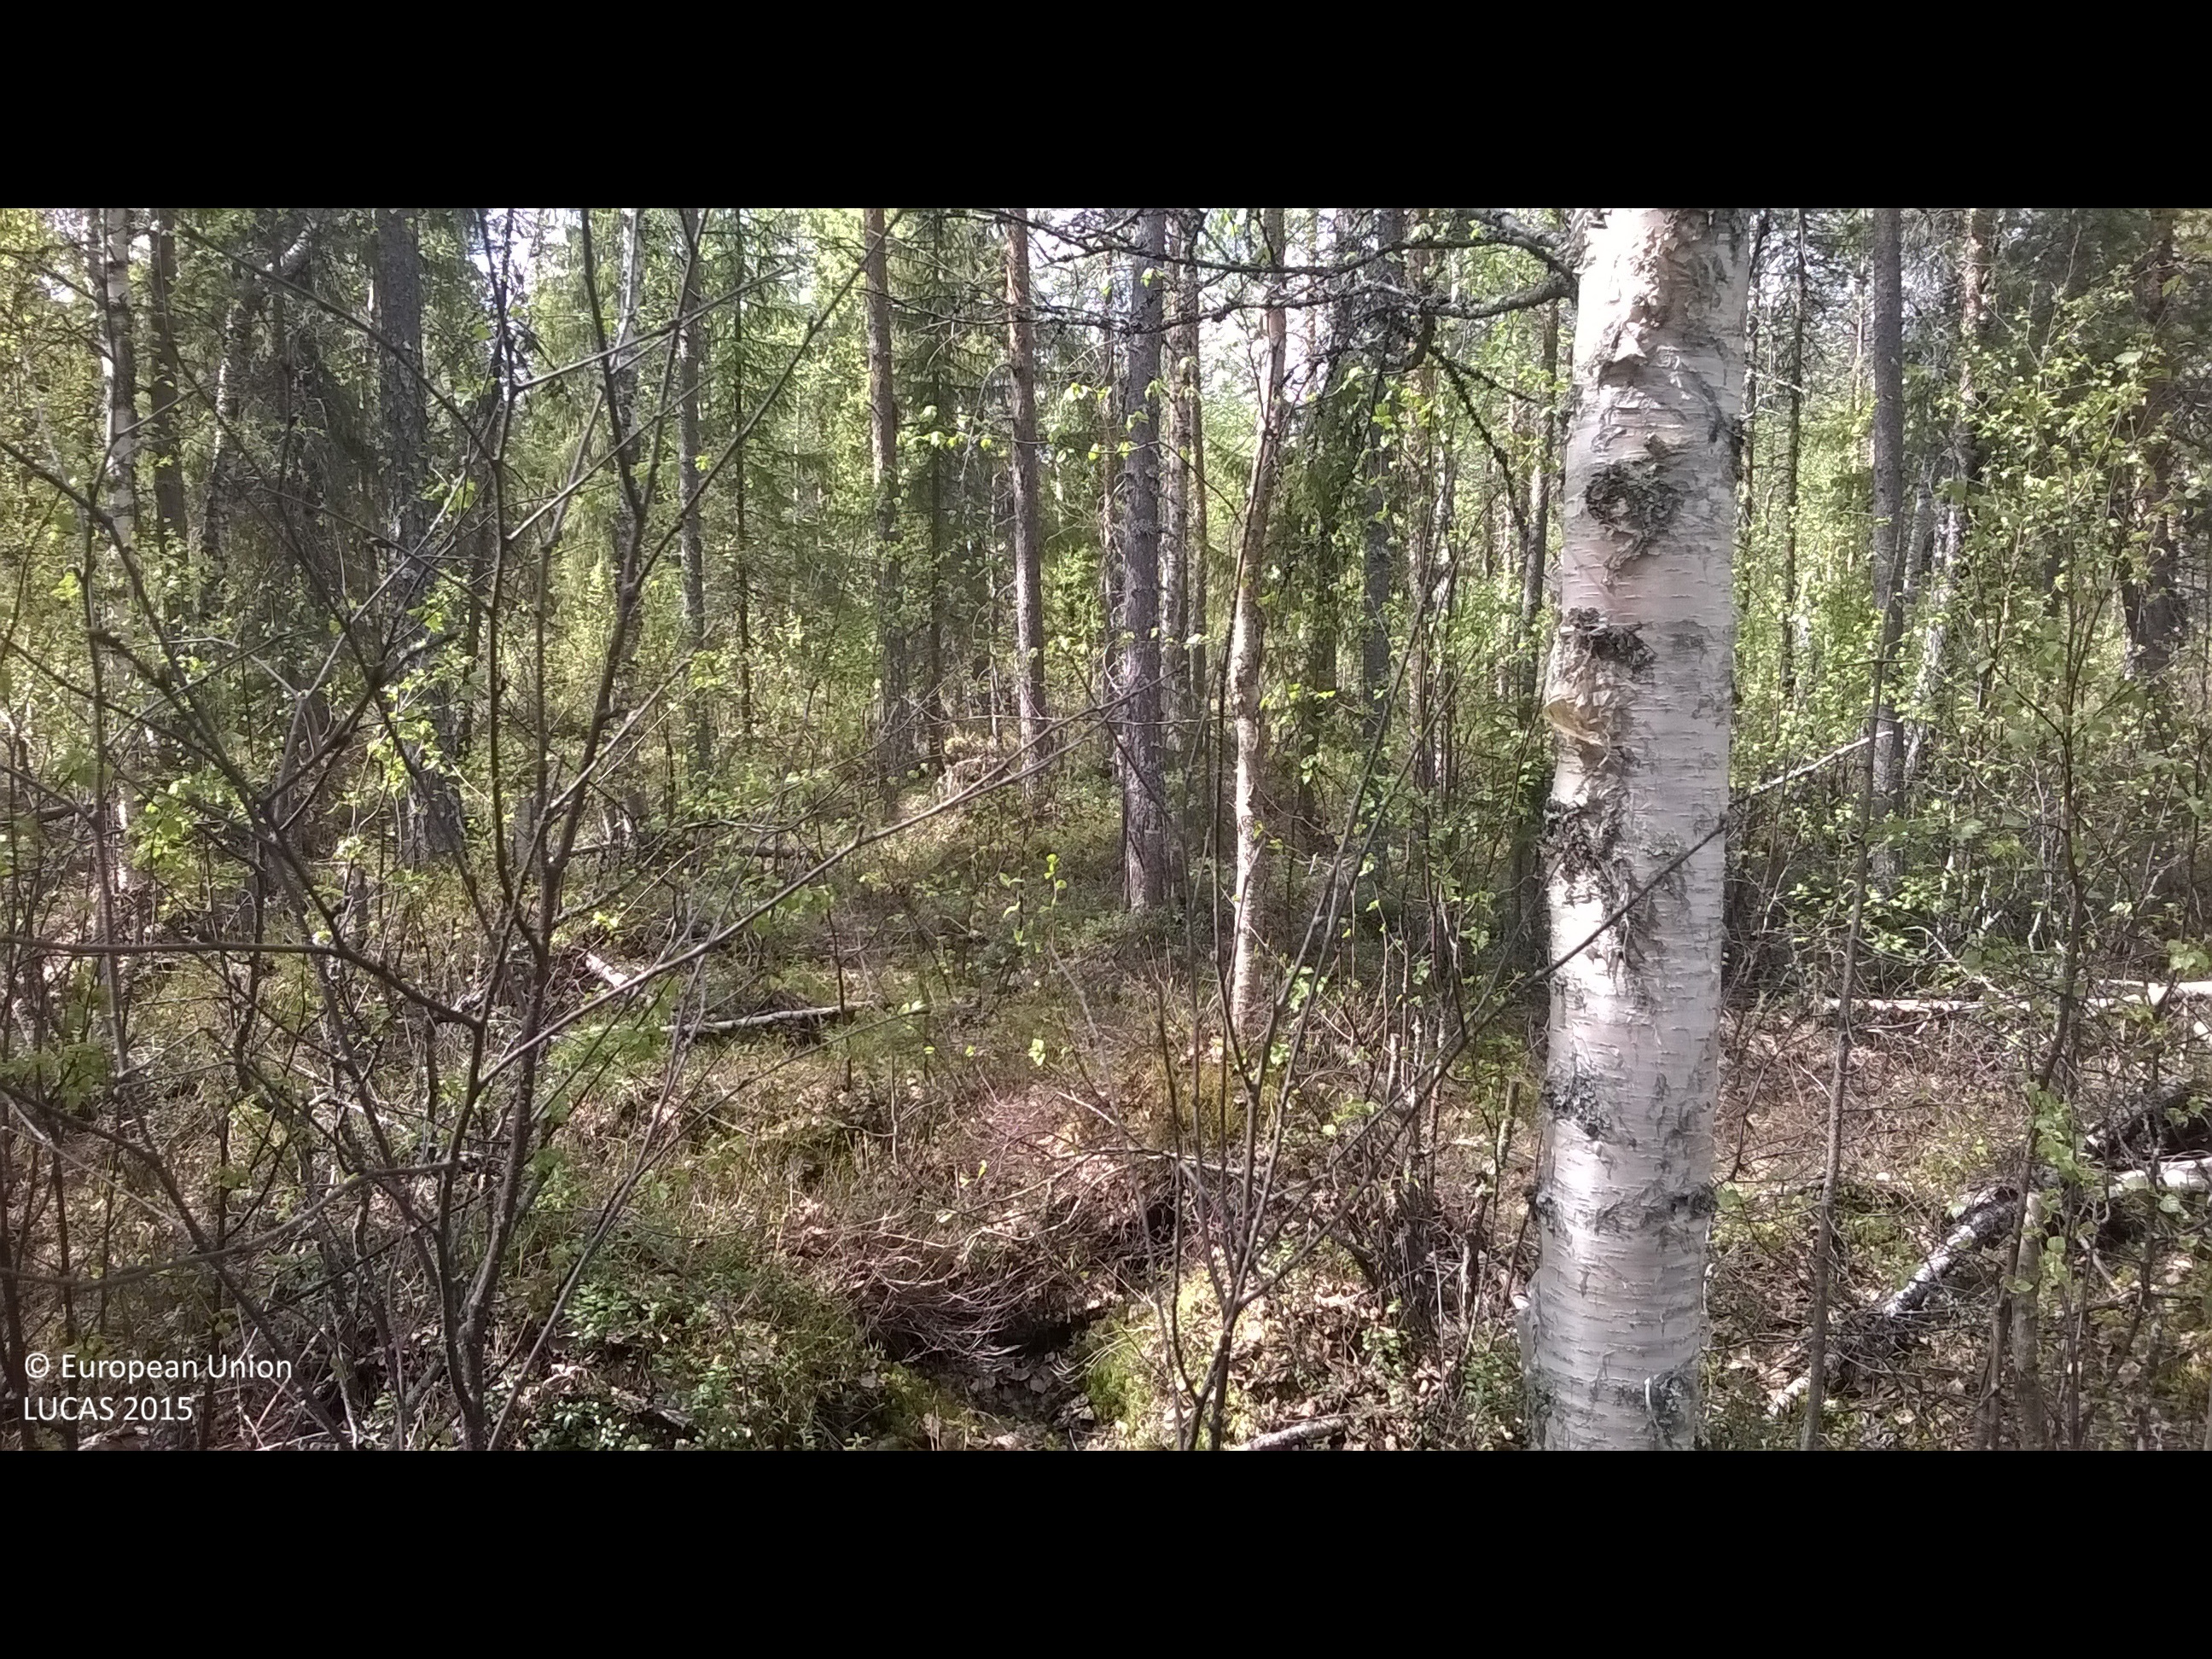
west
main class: Woodland
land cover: Pine dominated mixed woodland
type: boreal forest
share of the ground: > 75 %
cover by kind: broadleaved forest trees 60 %, coniferous forest trees 35 %, shrubs 5 %
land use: Forestry
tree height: > 5 m
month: June
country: FI
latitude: 66.5738
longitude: 26.4723
